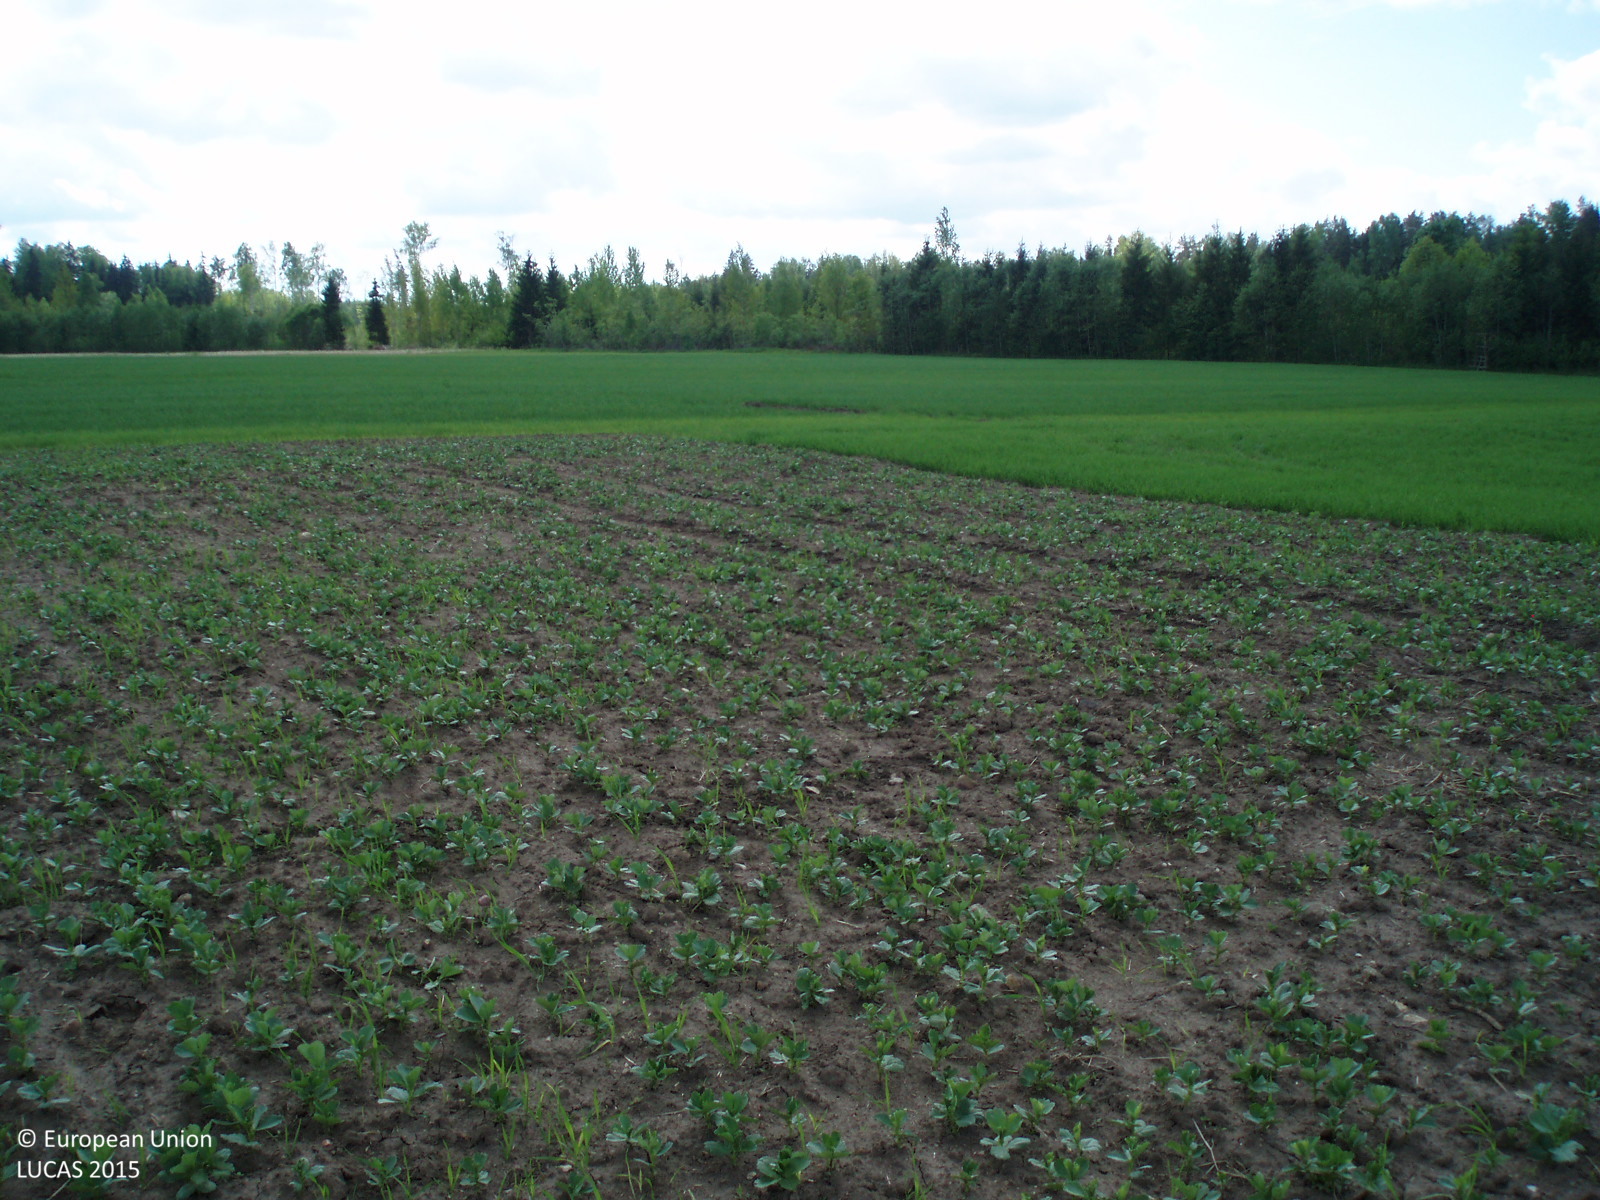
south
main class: Cropland
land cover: Dry pulses
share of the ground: 50 - 75 %
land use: Agriculture (excluding fallow land and kitchen gardens)
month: May
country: LT
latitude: 56.1758
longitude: 22.6740
